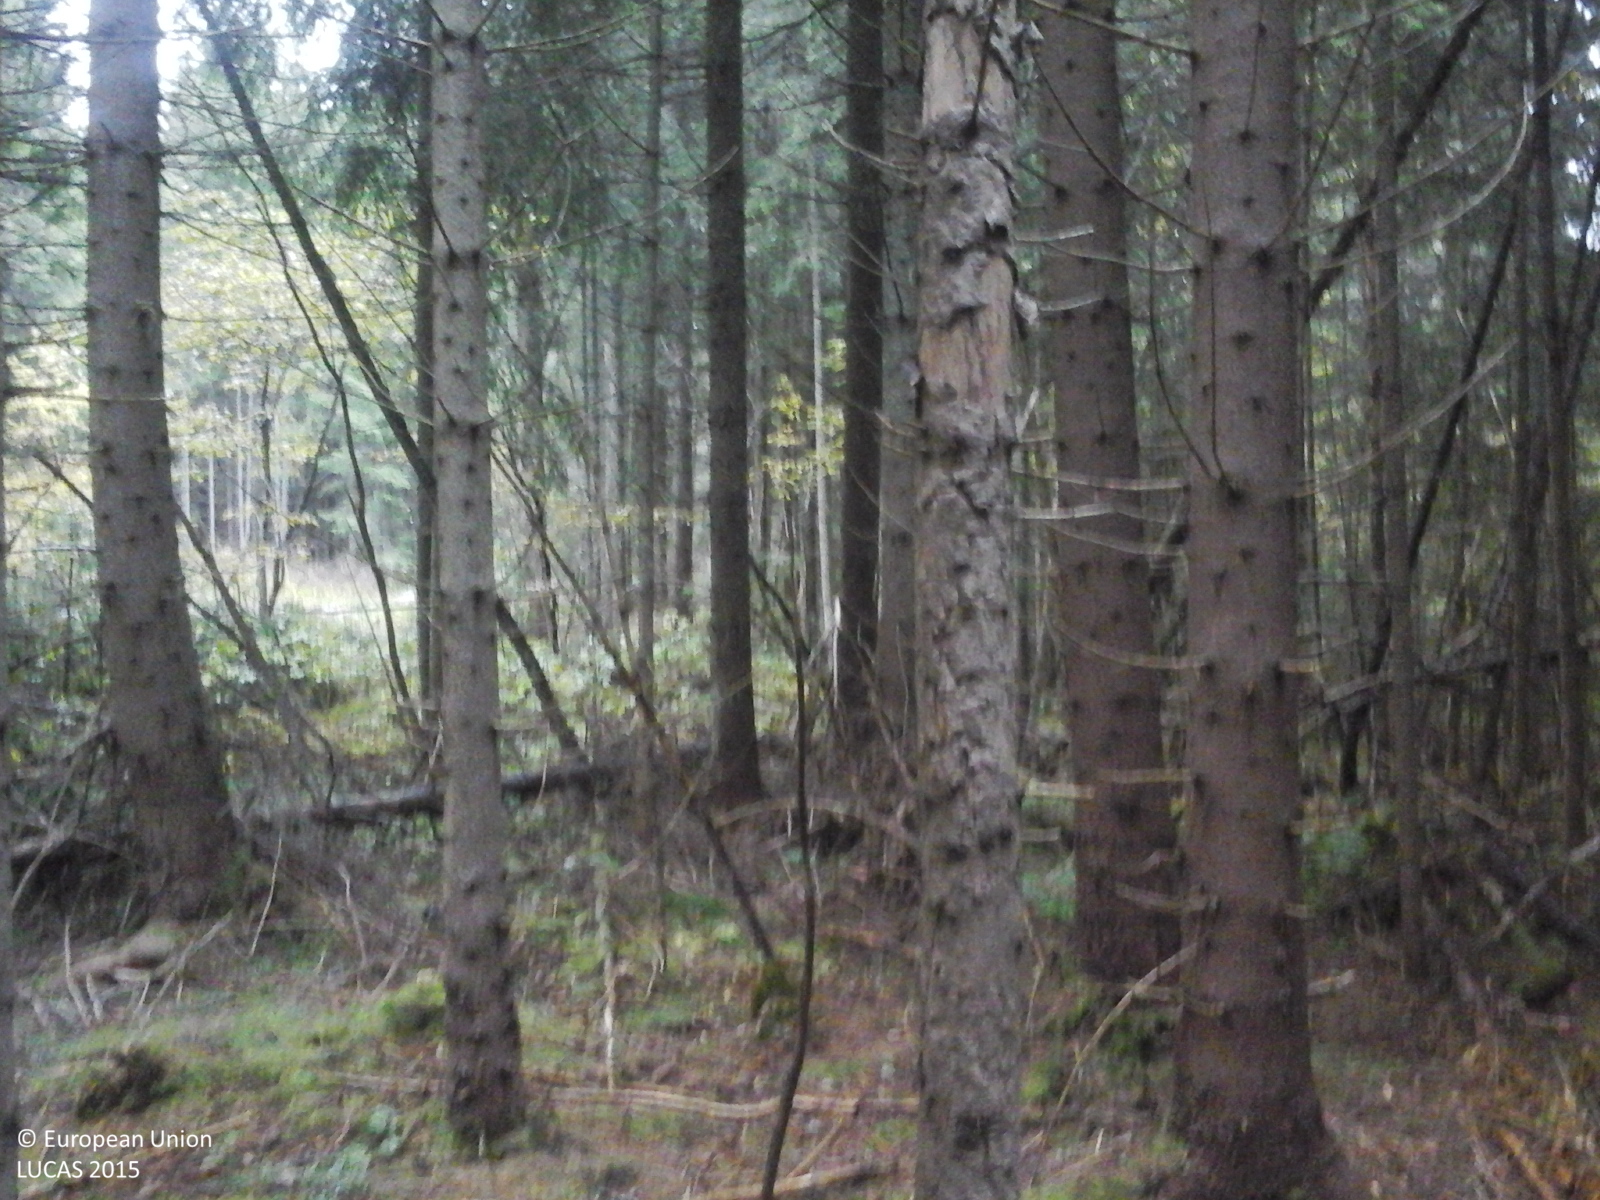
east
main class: Woodland
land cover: Spruce dominated coniferous woodland
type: alpine coniferous forest
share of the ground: > 75 %
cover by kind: coniferous forest trees 100 %
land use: Forestry
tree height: > 5 m
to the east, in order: Spruce dominated coniferous woodland; Paved roads, cycling and walking lanes; Spruce dominated coniferous woodland; Other mixed woodland
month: October
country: RO
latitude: 46.8291
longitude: 25.2200
